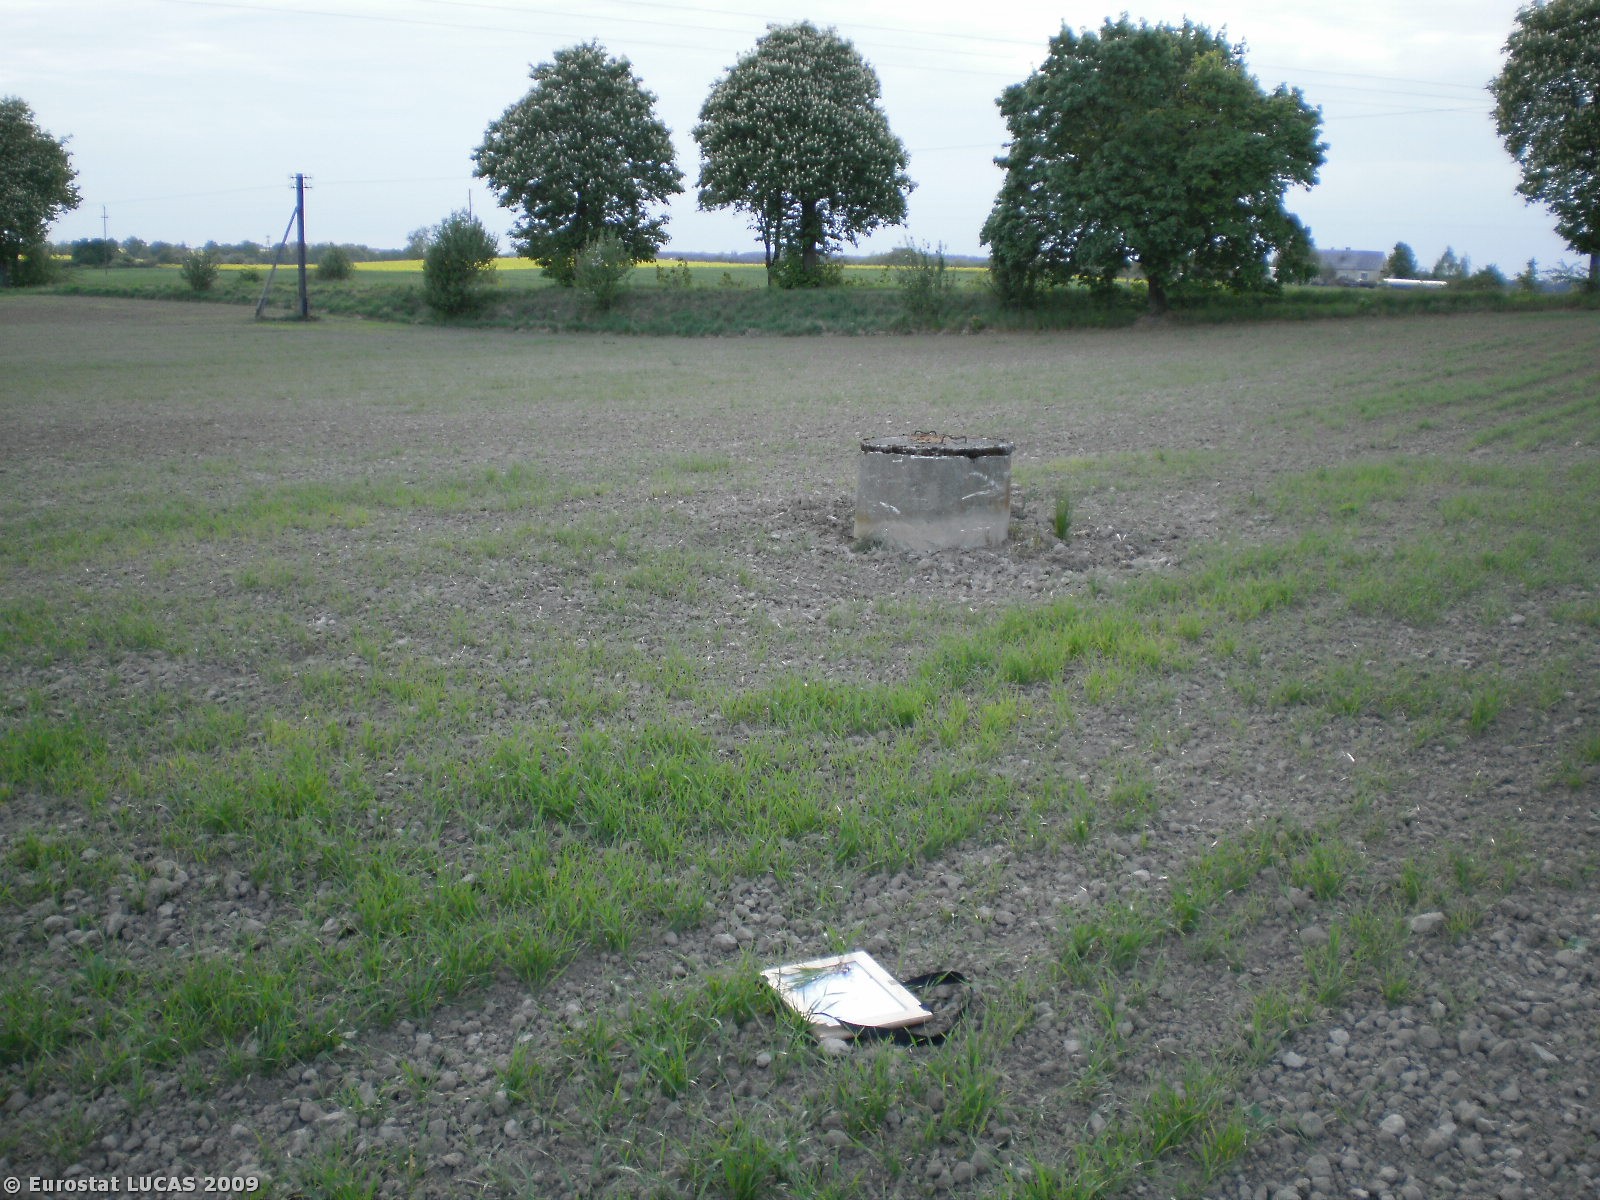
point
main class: Cropland
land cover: Common wheat
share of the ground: > 75 %
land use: Agriculture (excluding fallow land and kitchen gardens)
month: May
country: PL
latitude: 53.3696
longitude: 18.8130
